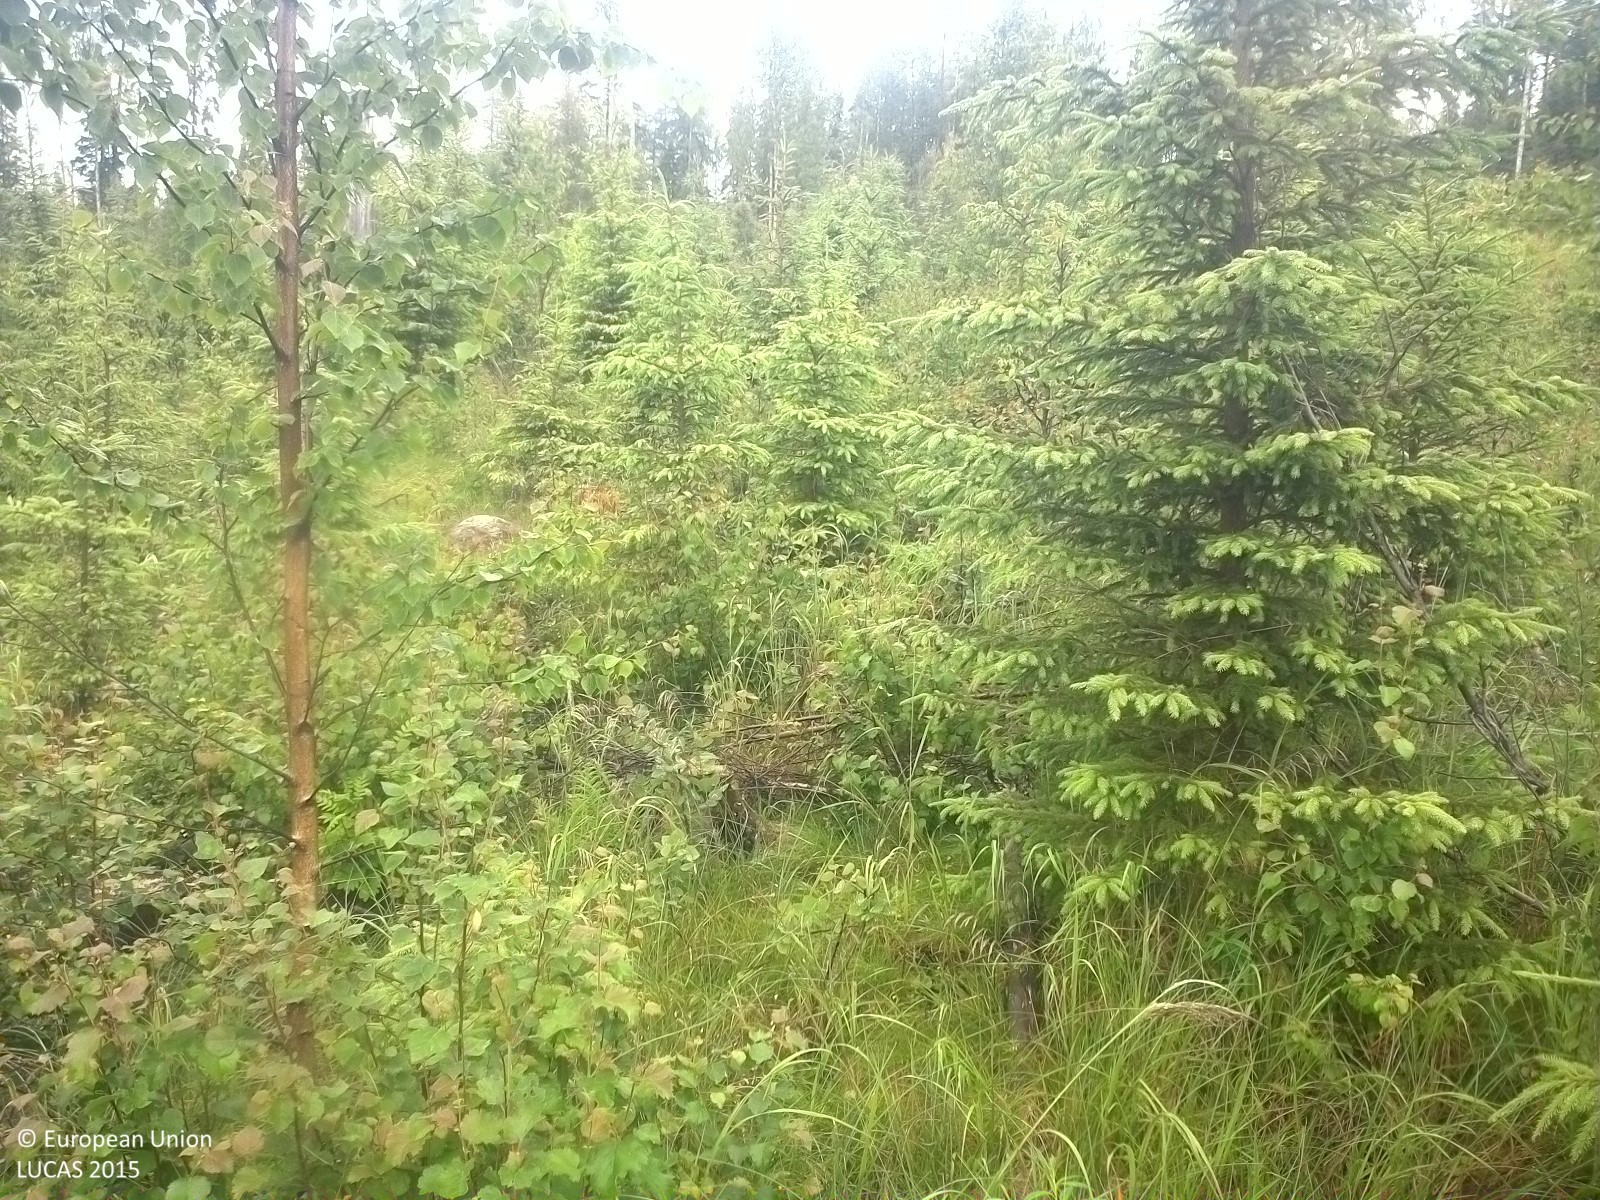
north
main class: Woodland
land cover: Spruce dominated mixed woodland
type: boreal forest
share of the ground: 50 - 75 %
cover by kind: herbaceous plants 45 %, coniferous forest trees 35 %, broadleaved forest trees 20 %
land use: Forestry
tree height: < 5 m
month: July
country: SE
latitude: 62.5277
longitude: 16.8771
